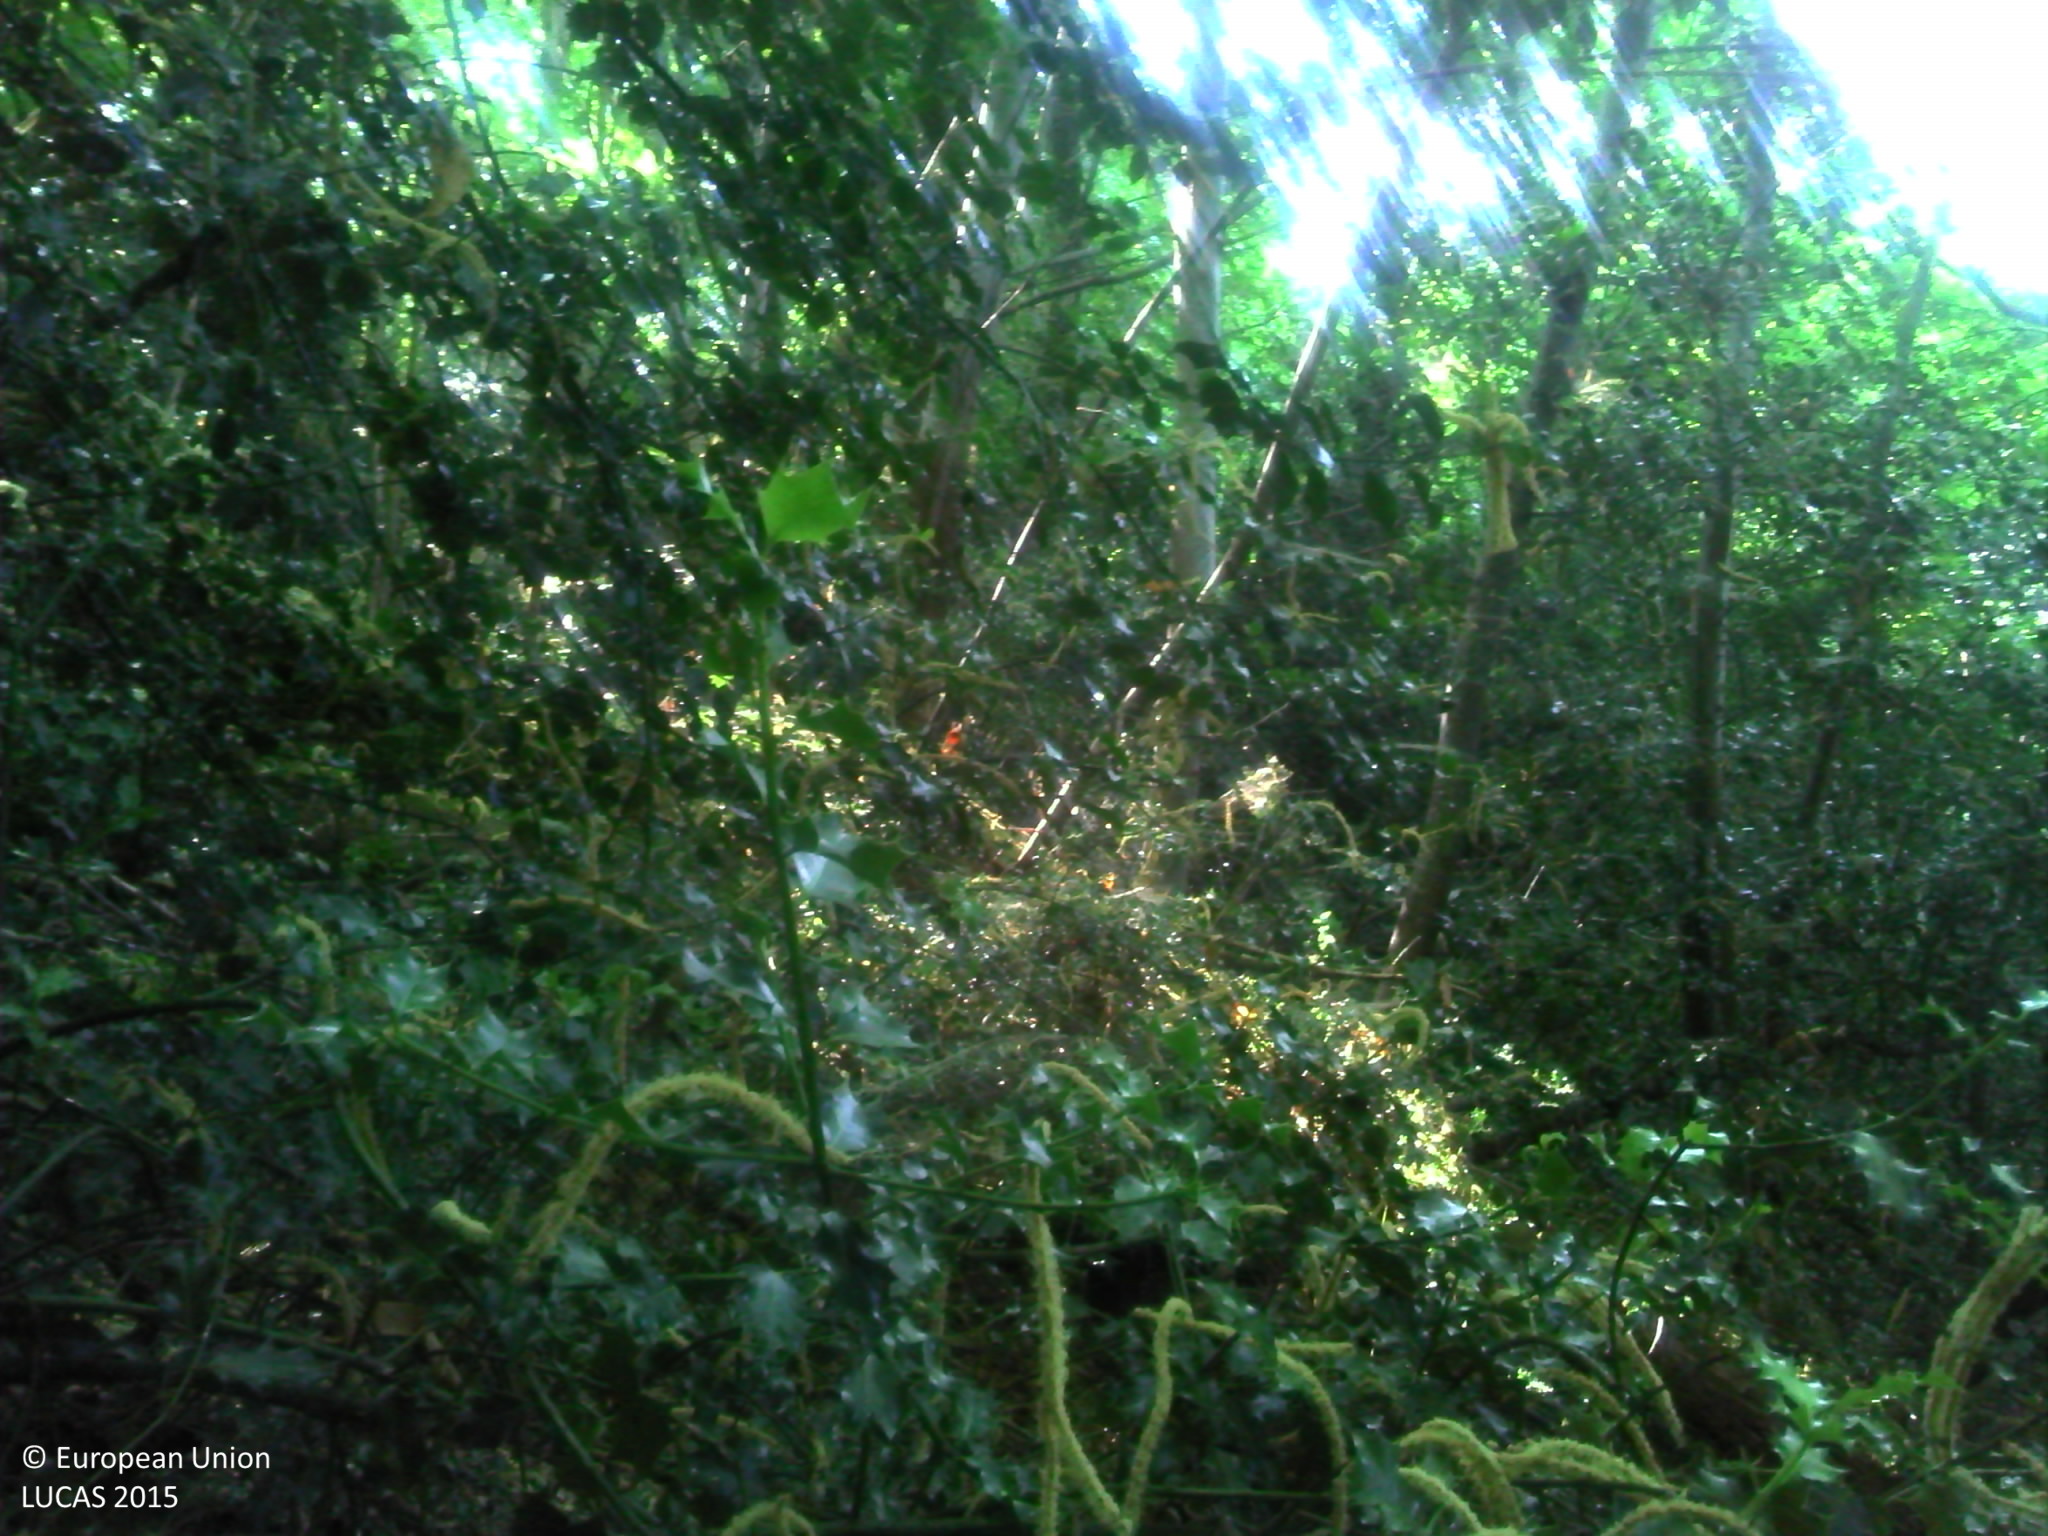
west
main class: Woodland
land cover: Broadleaved woodland
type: mesophytic deciduous forest
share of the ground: > 75 %
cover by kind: broadleaved forest trees 100 %
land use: Forestry
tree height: > 5 m
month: July
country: FR
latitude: 46.2694
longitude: 1.5438
